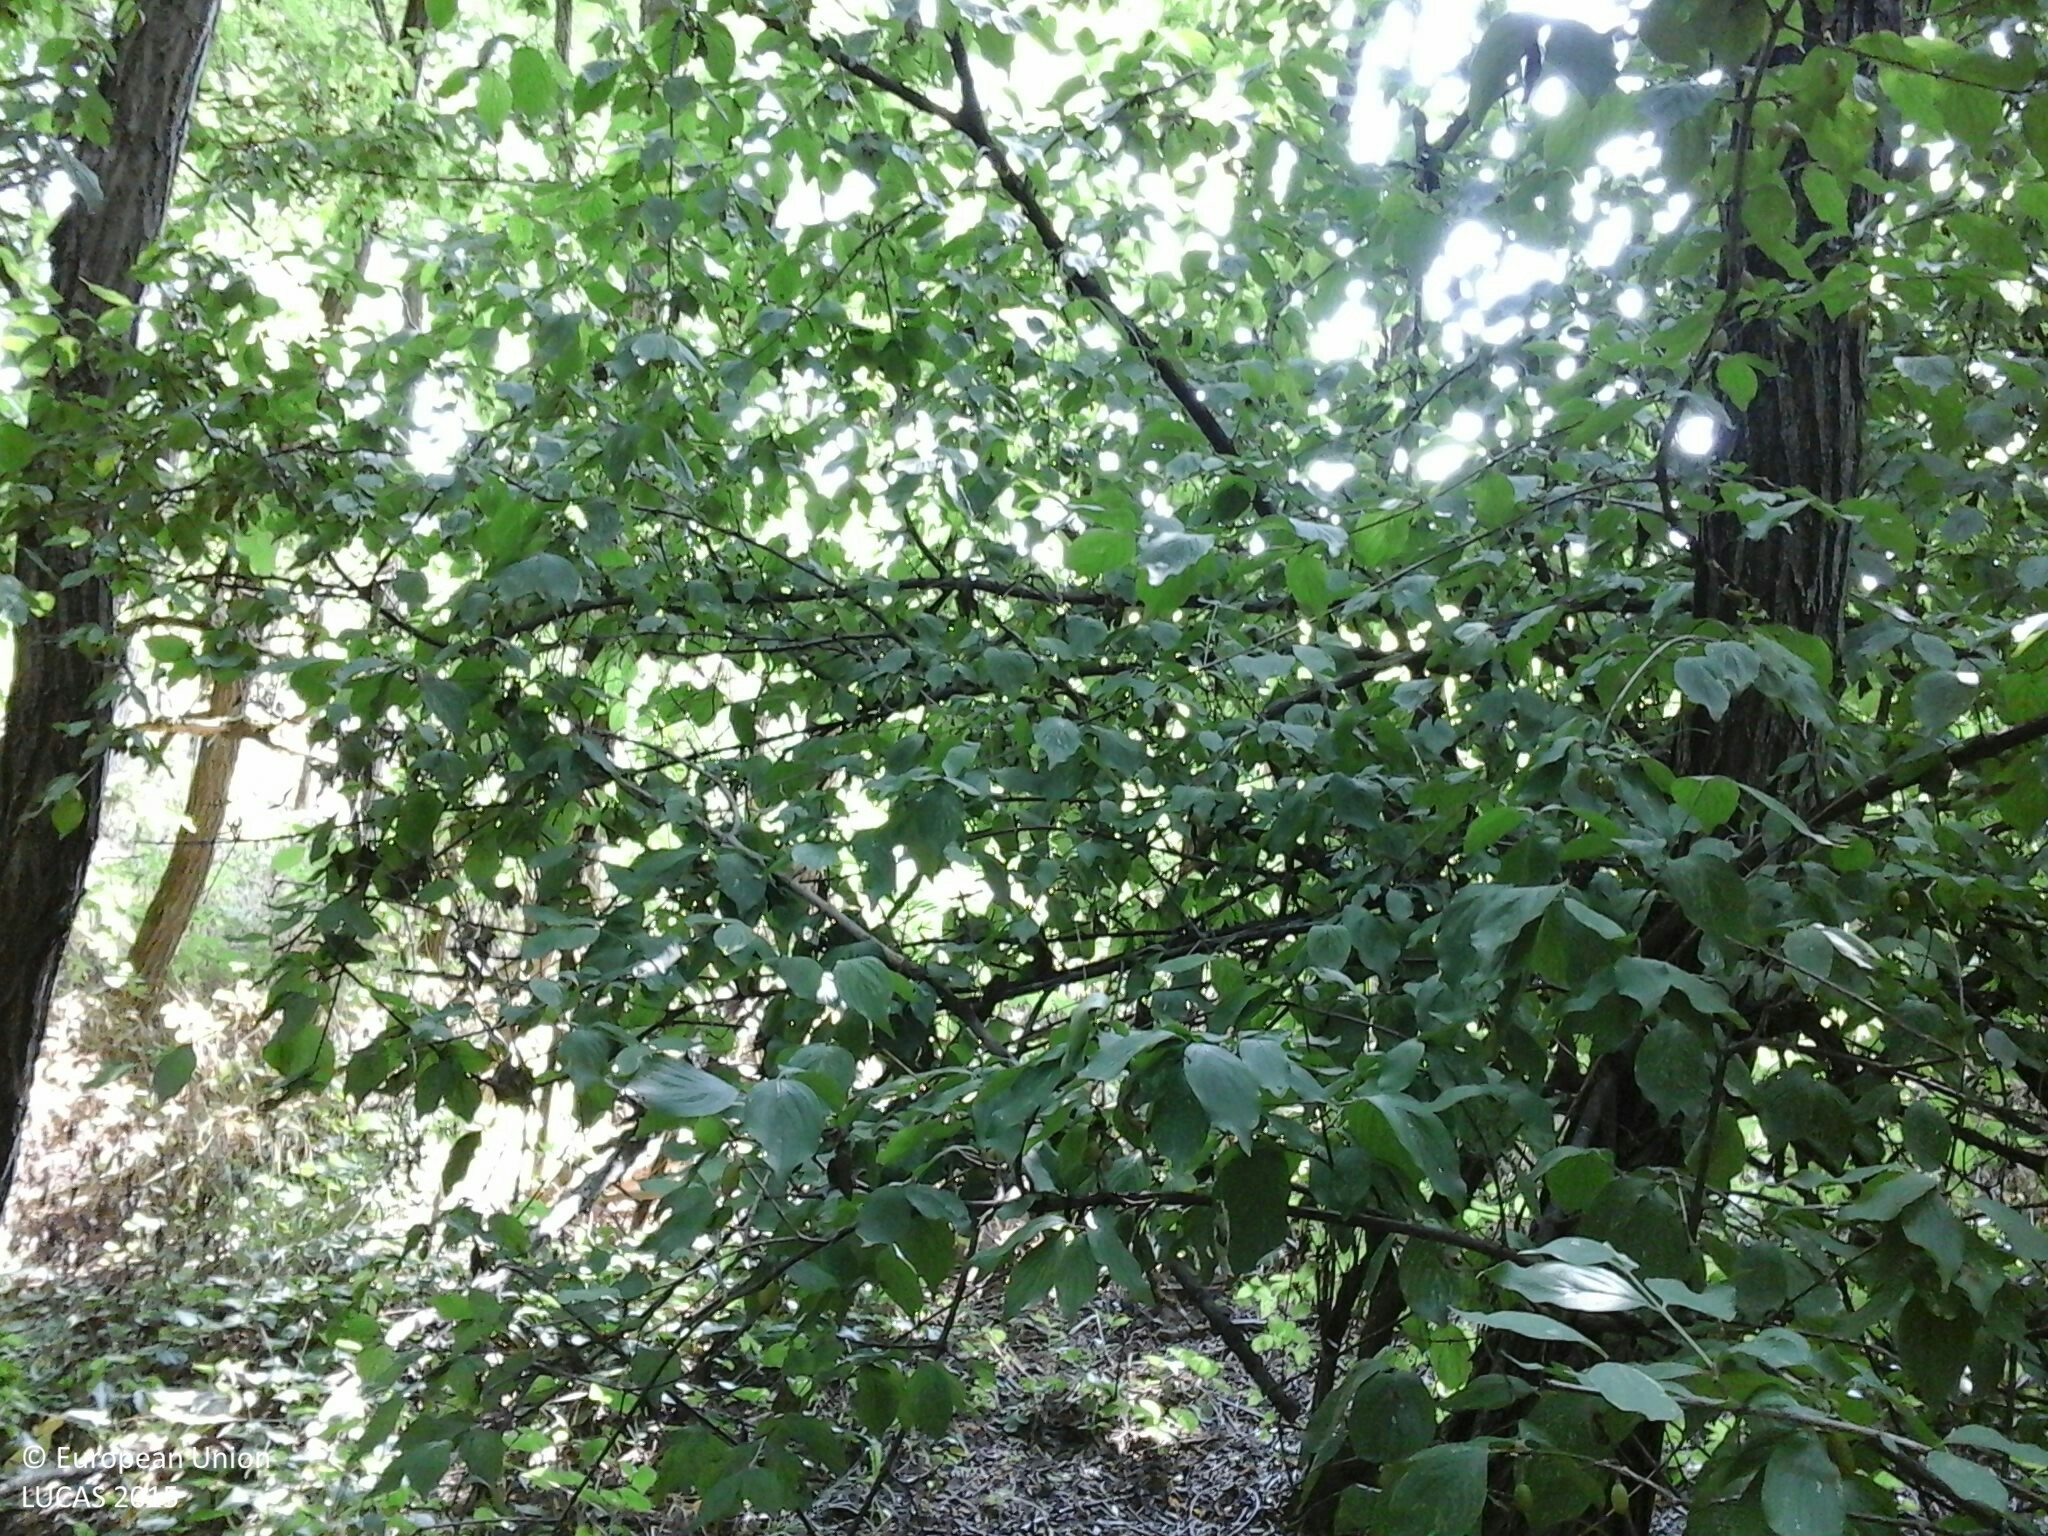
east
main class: Woodland
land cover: Broadleaved woodland
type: mesophytic deciduous forest
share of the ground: > 75 %
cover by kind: broadleaved forest trees 85 %, shrubs 10 %, herbaceous plants 5 %
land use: Forestry
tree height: > 5 m
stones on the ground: < 10 %
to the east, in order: Broadleaved woodland; Tracks; Broadleaved woodland
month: August
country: HU
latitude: 46.7128
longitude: 18.1061
